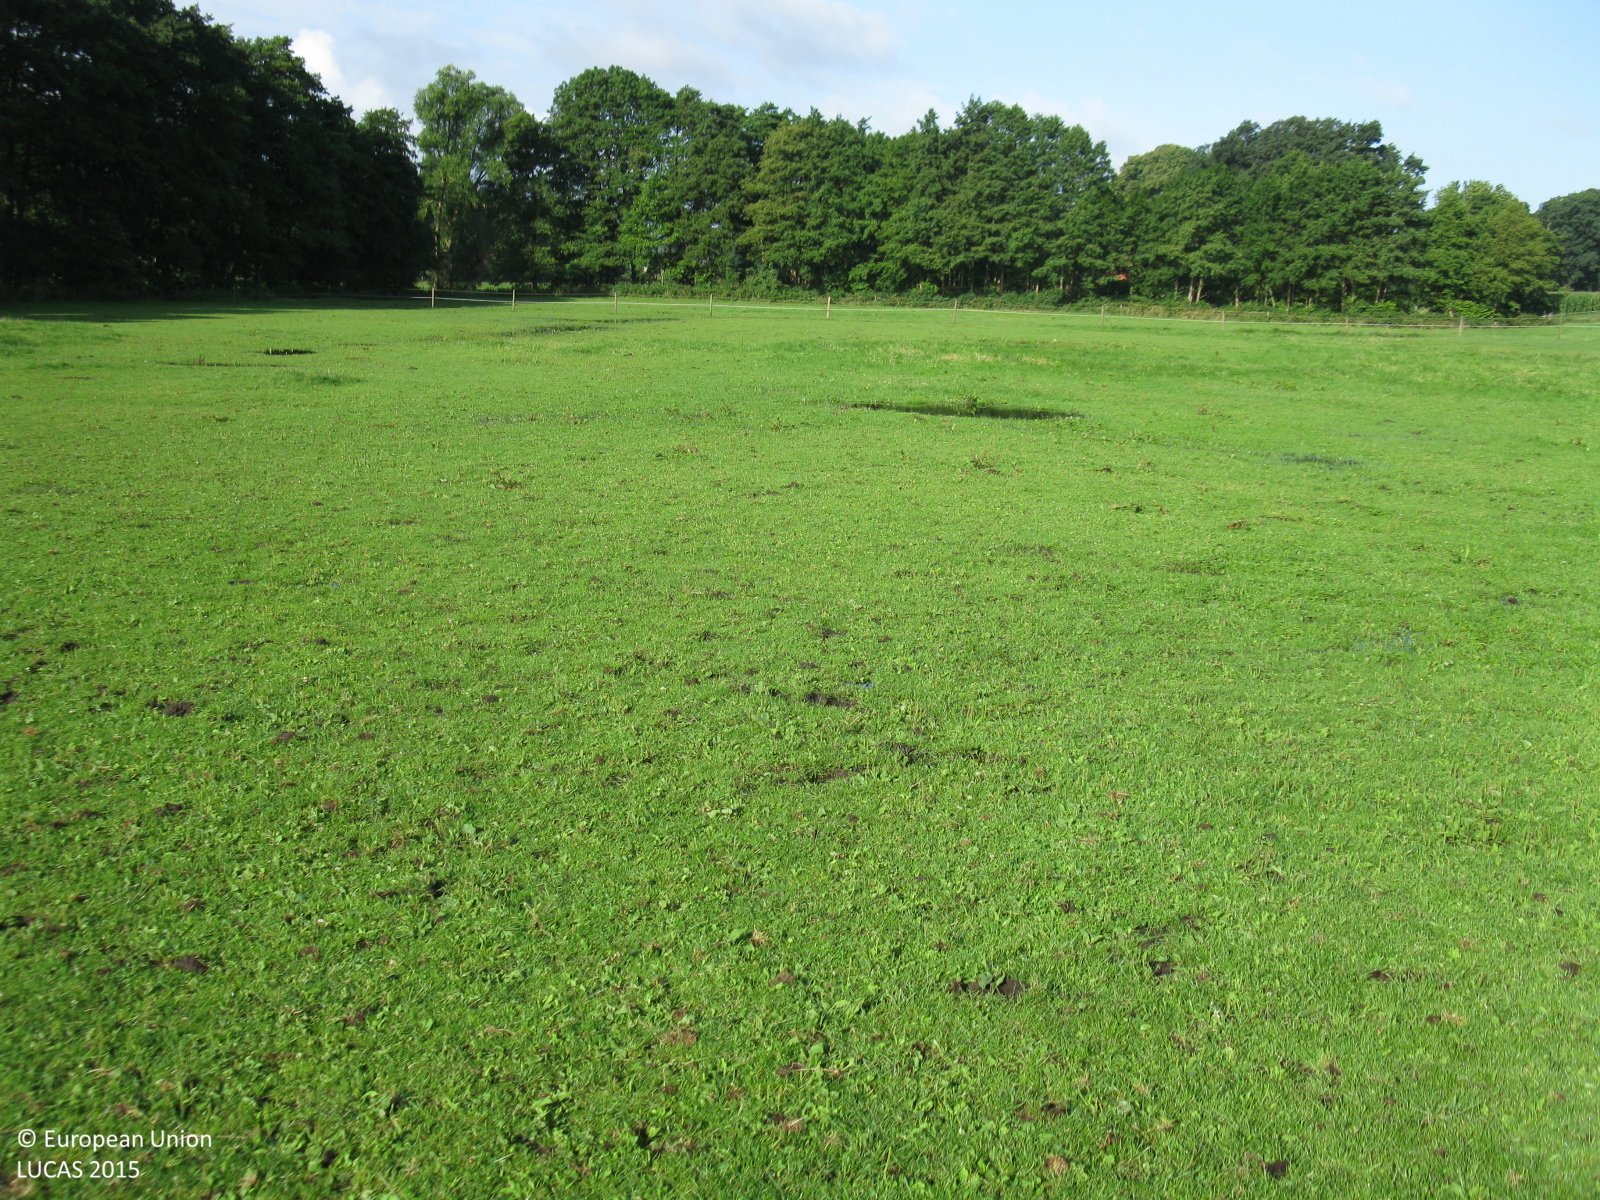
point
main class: Grassland
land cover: Grassland without tree/shrub cover
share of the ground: > 75 %
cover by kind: herbaceous plants 100 %
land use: Agriculture (excluding fallow land and kitchen gardens)
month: July
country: DE
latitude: 53.0521
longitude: 8.5833
